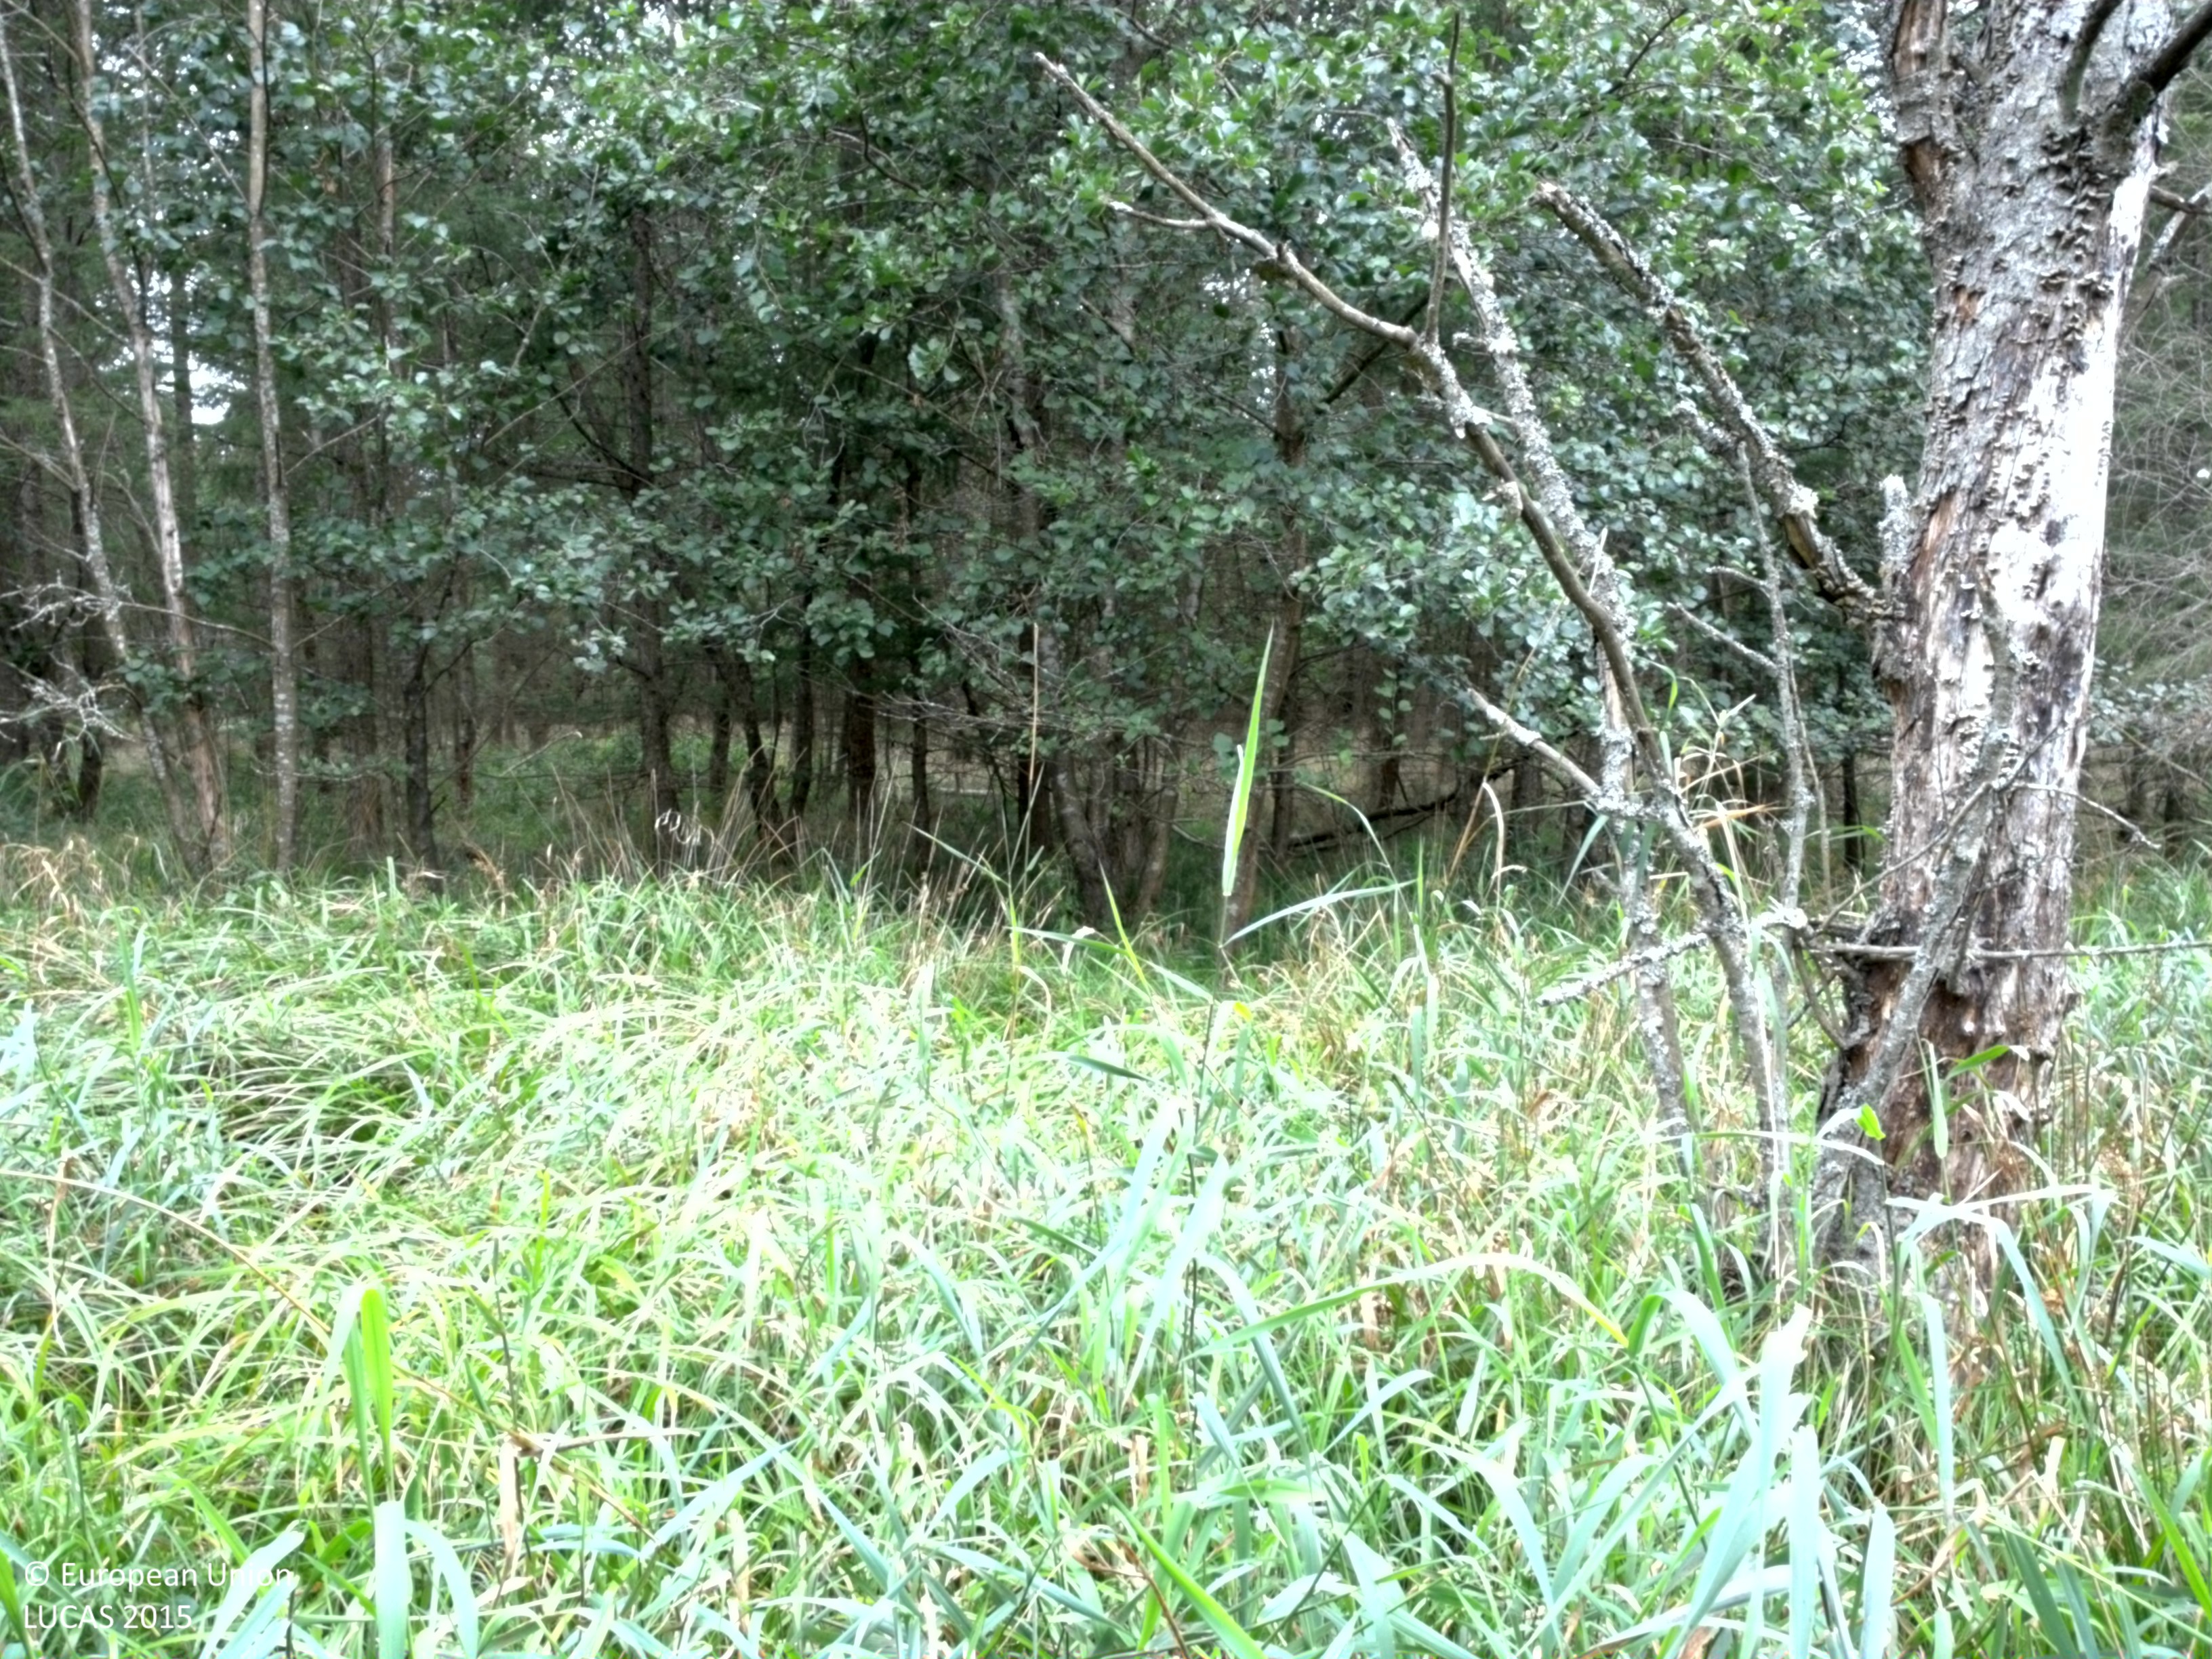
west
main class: Woodland
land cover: Broadleaved woodland
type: mesophytic deciduous forest
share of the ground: 25 - 50 %
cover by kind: herbaceous plants 50 %, broadleaved forest trees 40 %, shrubs 10 %
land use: Forestry
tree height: < 5 m
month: September
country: SE
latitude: 55.5409
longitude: 13.6906
